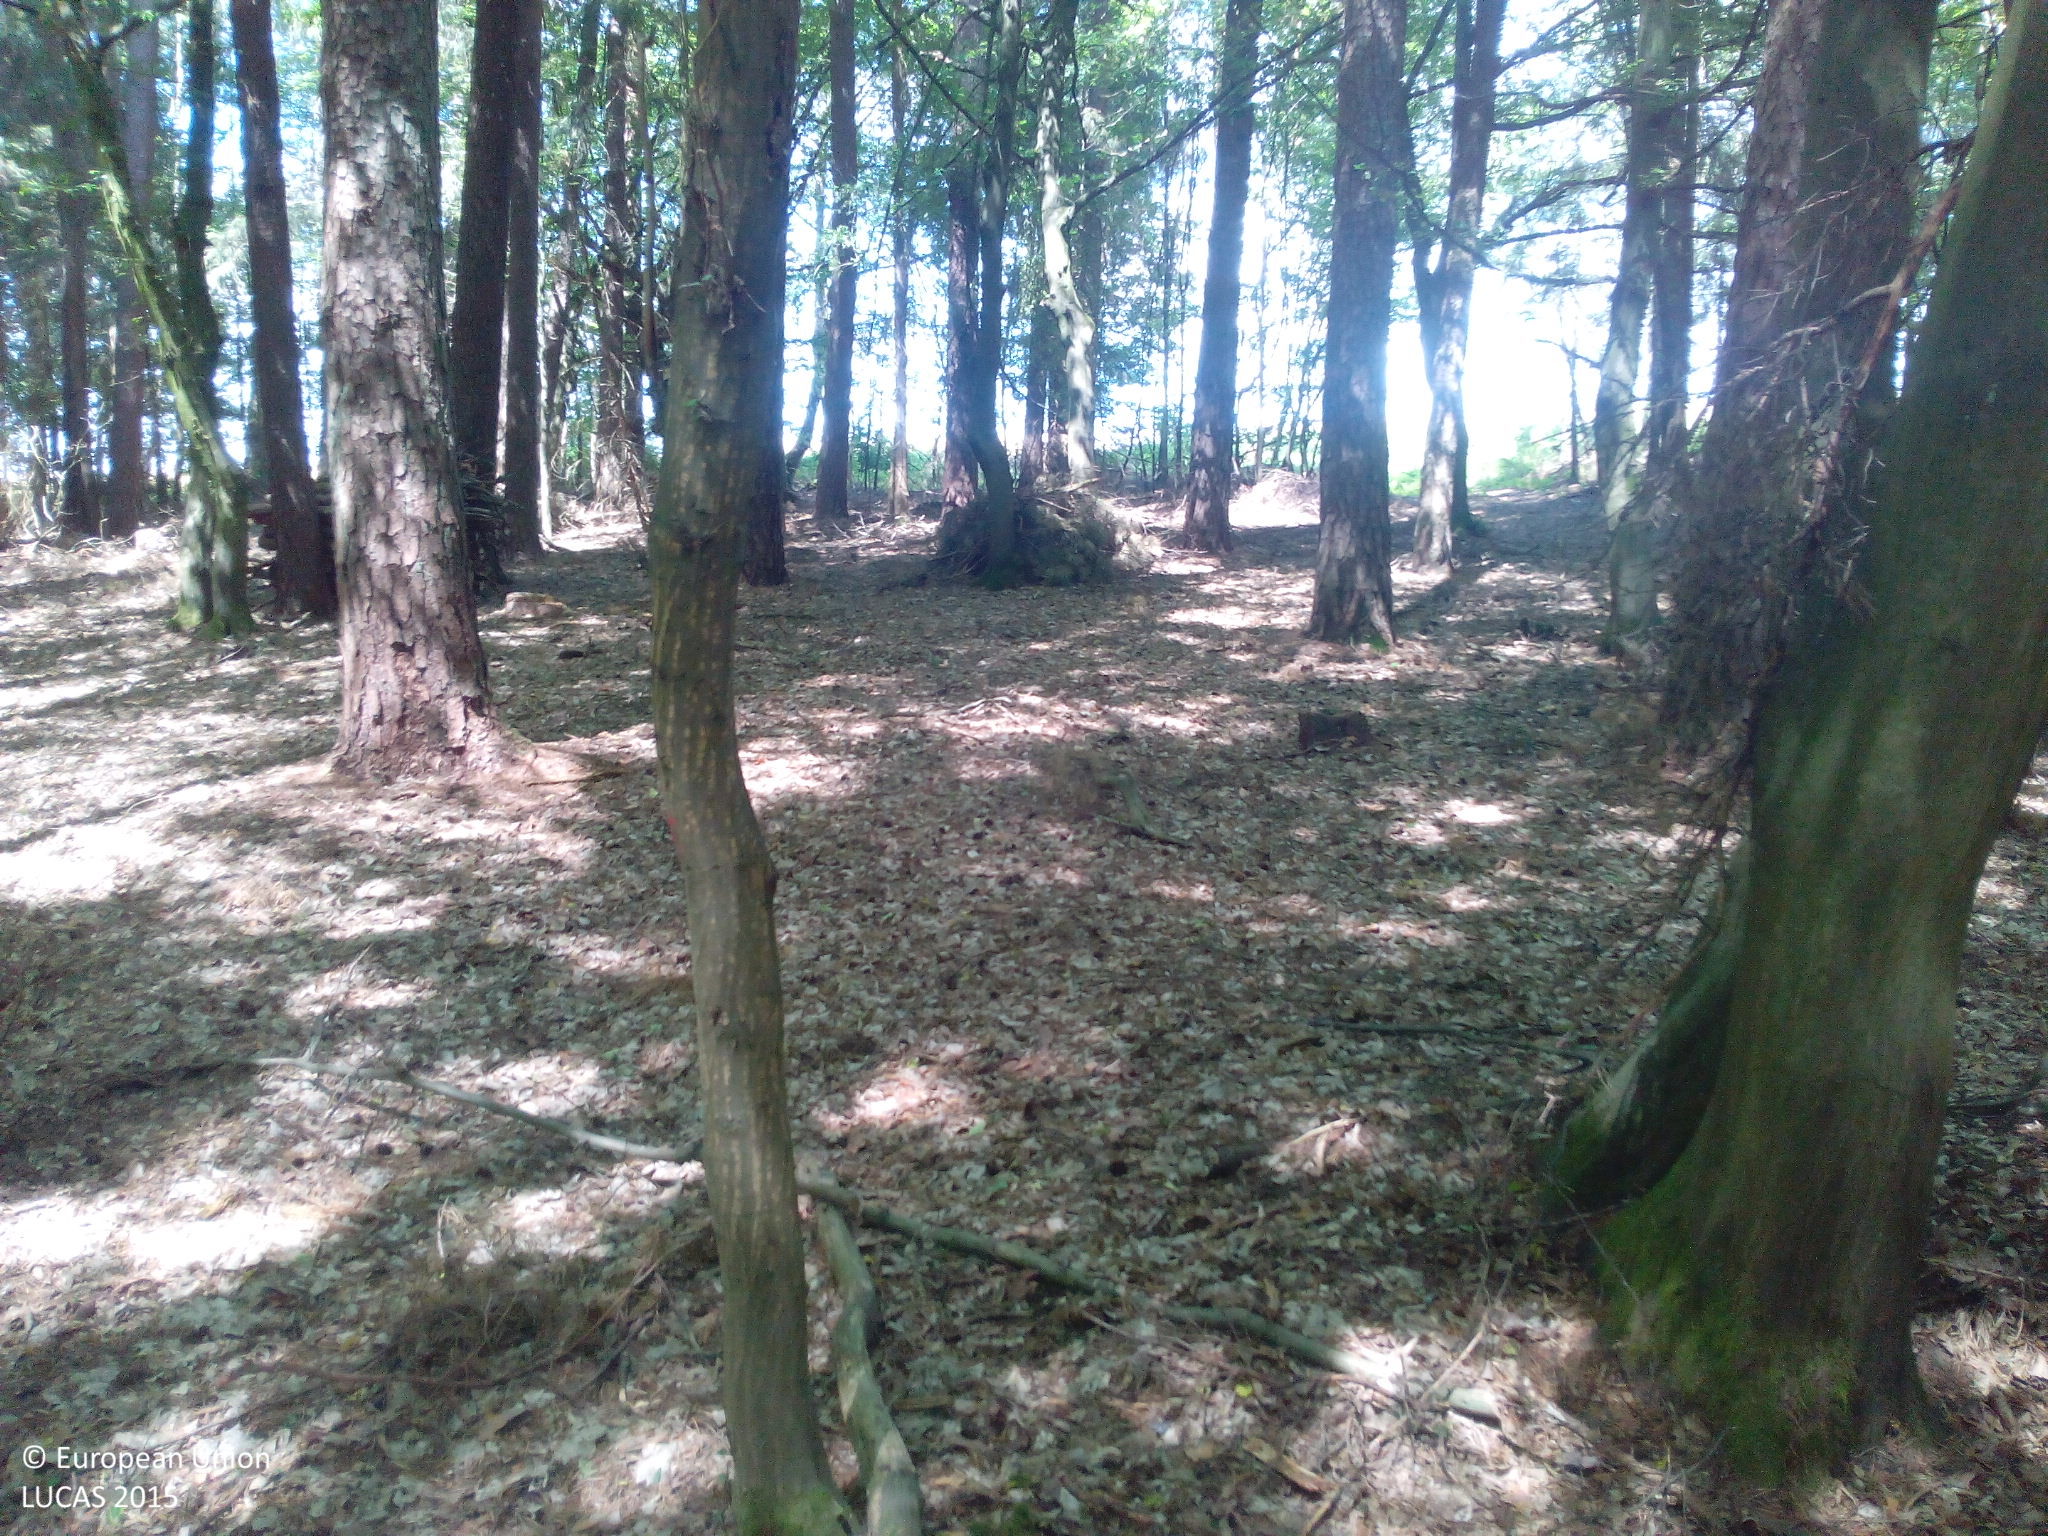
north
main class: Woodland
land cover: Pine dominated mixed woodland
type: hemiboreal forest and nemoral coniferous forest and mixed broadleaved-coniferous forest
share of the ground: > 75 %
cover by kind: coniferous forest trees 60 %, broadleaved forest trees 35 %, unconsolidated bare surface 5 %
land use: Forestry
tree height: > 5 m
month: July
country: DE
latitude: 49.7512
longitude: 10.5688
